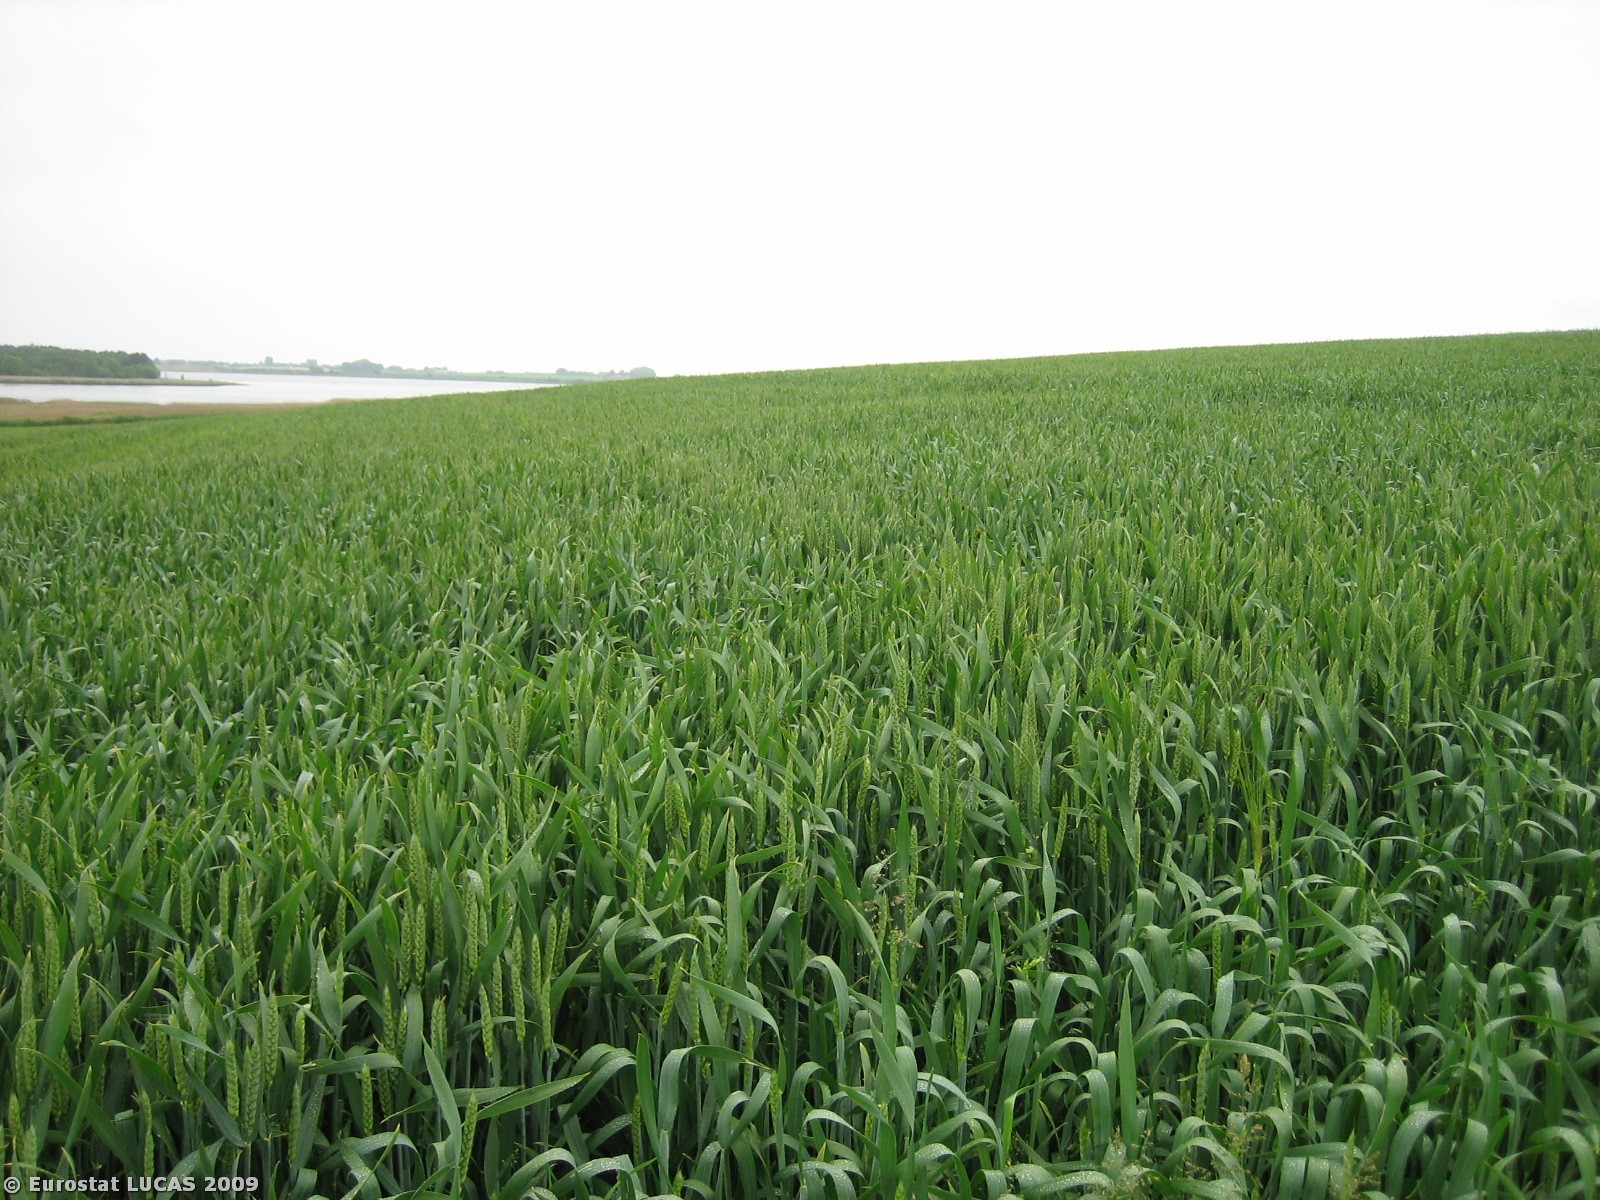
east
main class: Cropland
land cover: Common wheat
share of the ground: > 75 %
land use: Agriculture (excluding fallow land and kitchen gardens)
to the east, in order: Common wheat
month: June
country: DK
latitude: 56.0078
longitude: 10.2083
